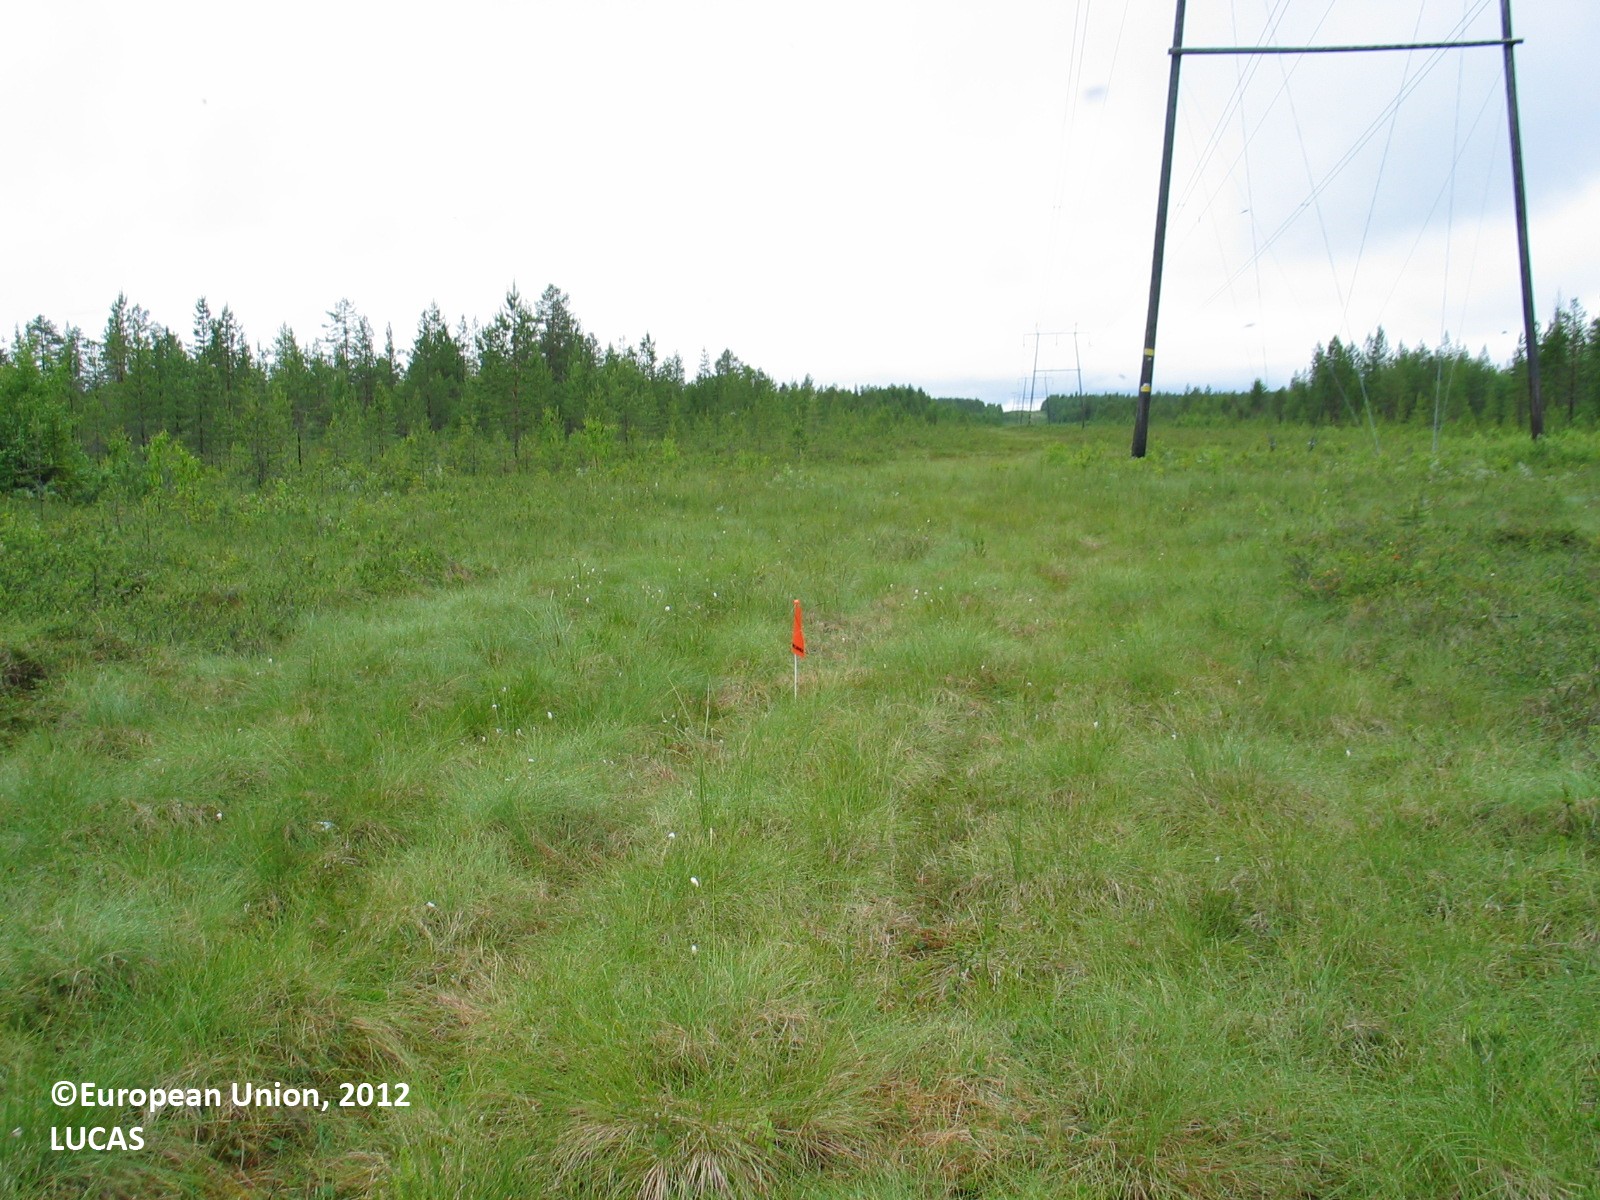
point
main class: Grassland
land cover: Grassland without tree/shrub cover
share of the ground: > 75 %
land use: Energy production
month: July
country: FI
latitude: 66.0444
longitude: 25.0025
